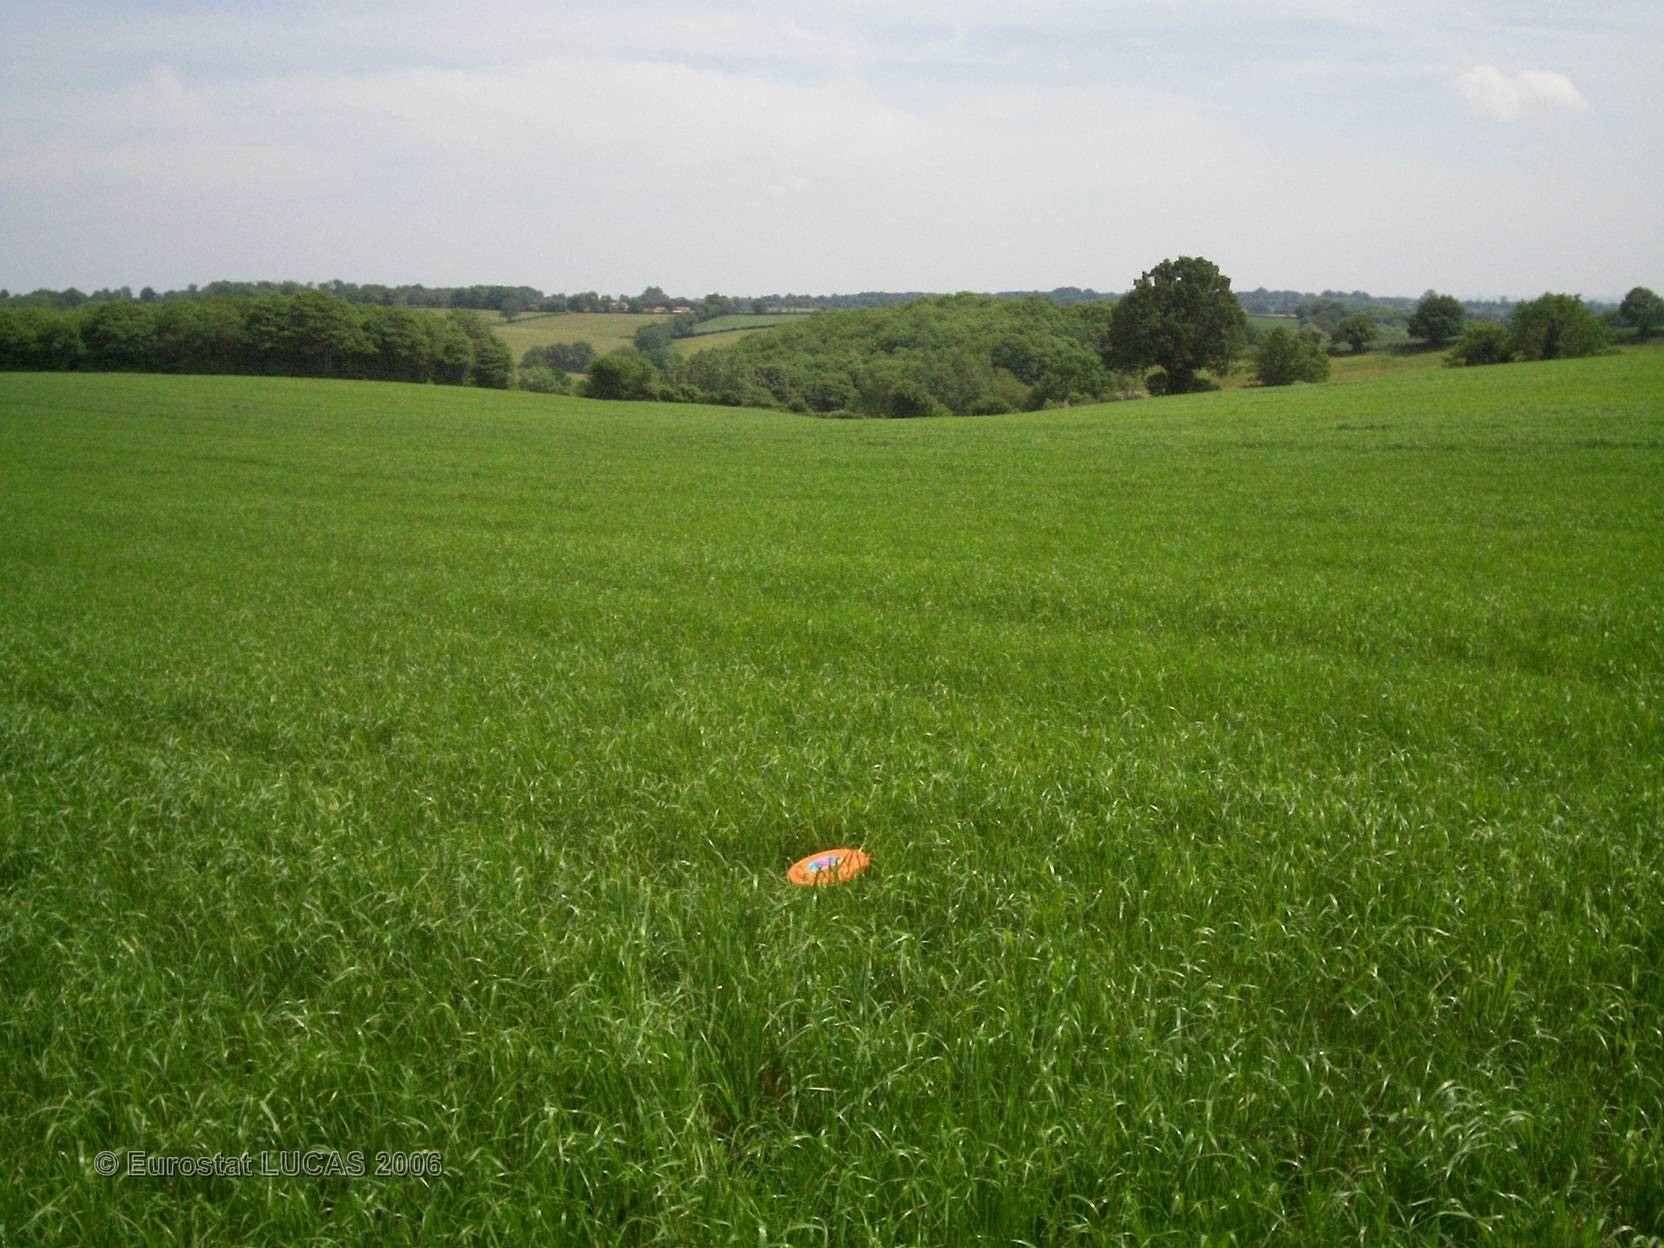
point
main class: Grassland
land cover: Grassland without tree/shrub cover
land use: Agriculture (excluding fallow land and kitchen gardens)
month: May
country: FR
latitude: 46.4876
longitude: -0.3030
